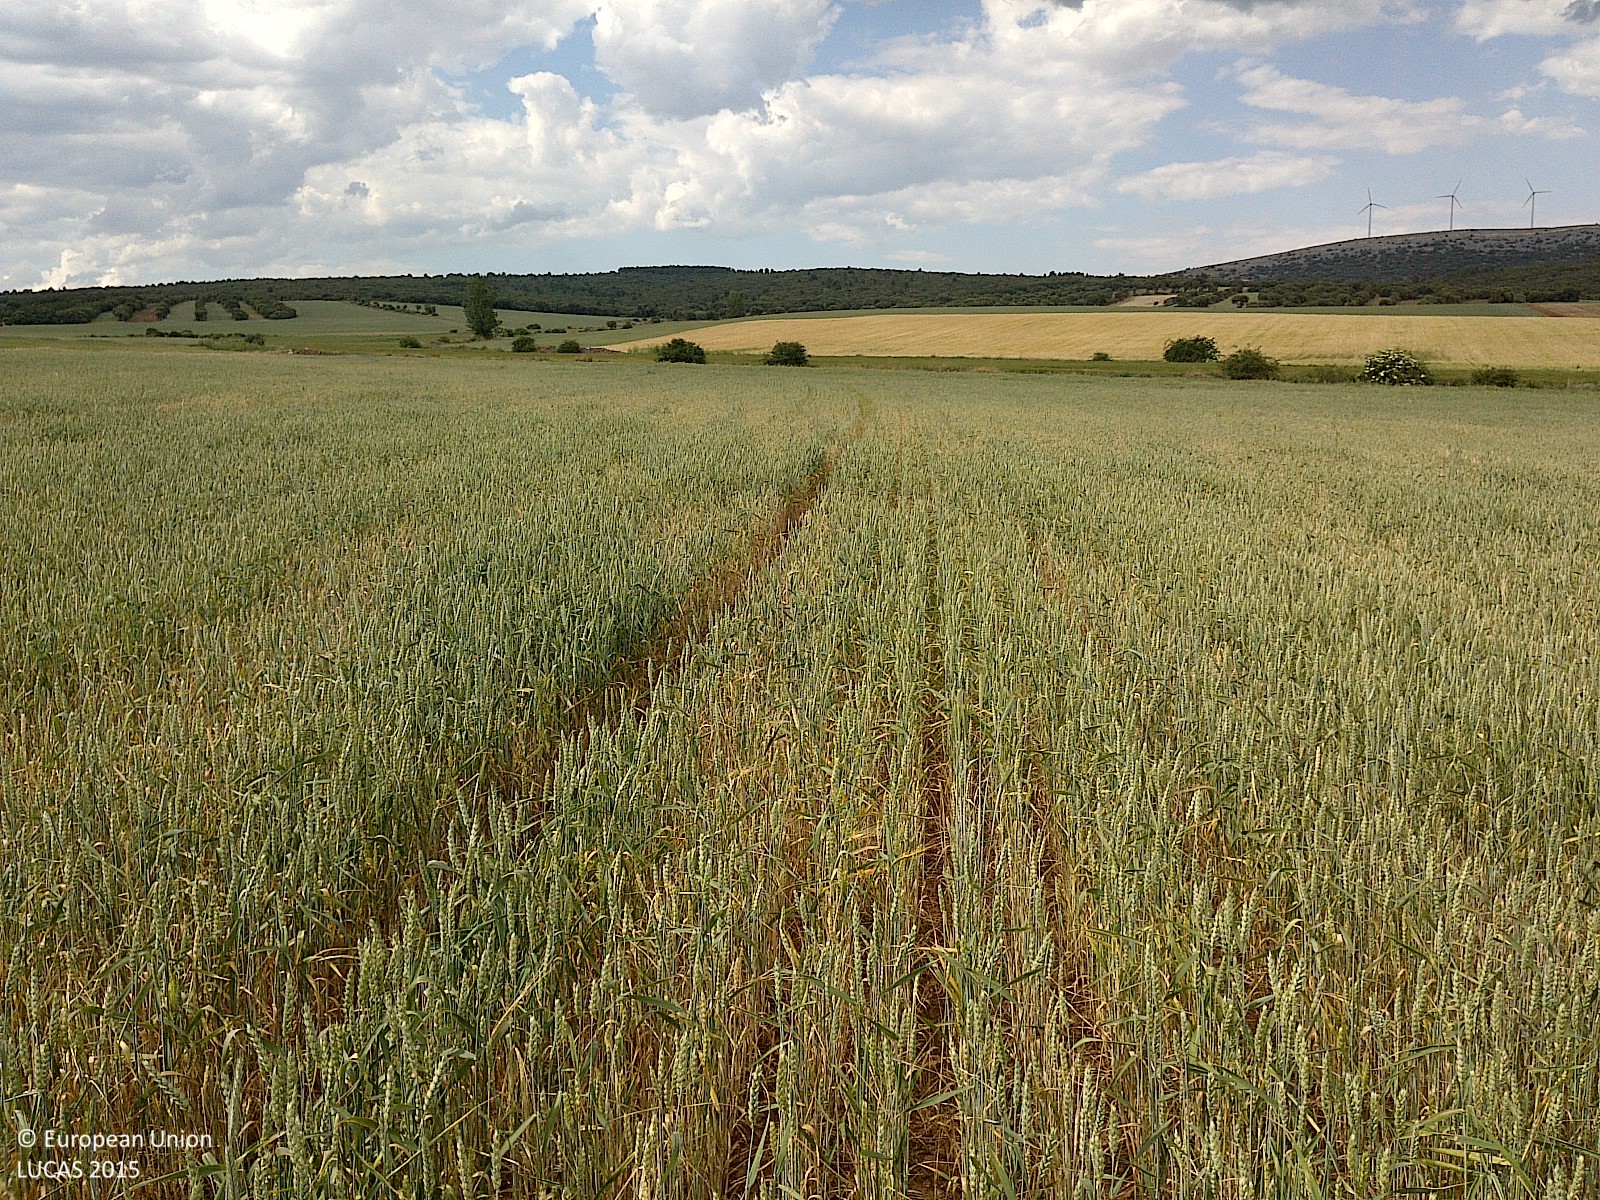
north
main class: Cropland
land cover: Common wheat
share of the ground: > 75 %
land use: Agriculture (excluding fallow land and kitchen gardens)
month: June
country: ES
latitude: 41.7295
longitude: -2.2131
